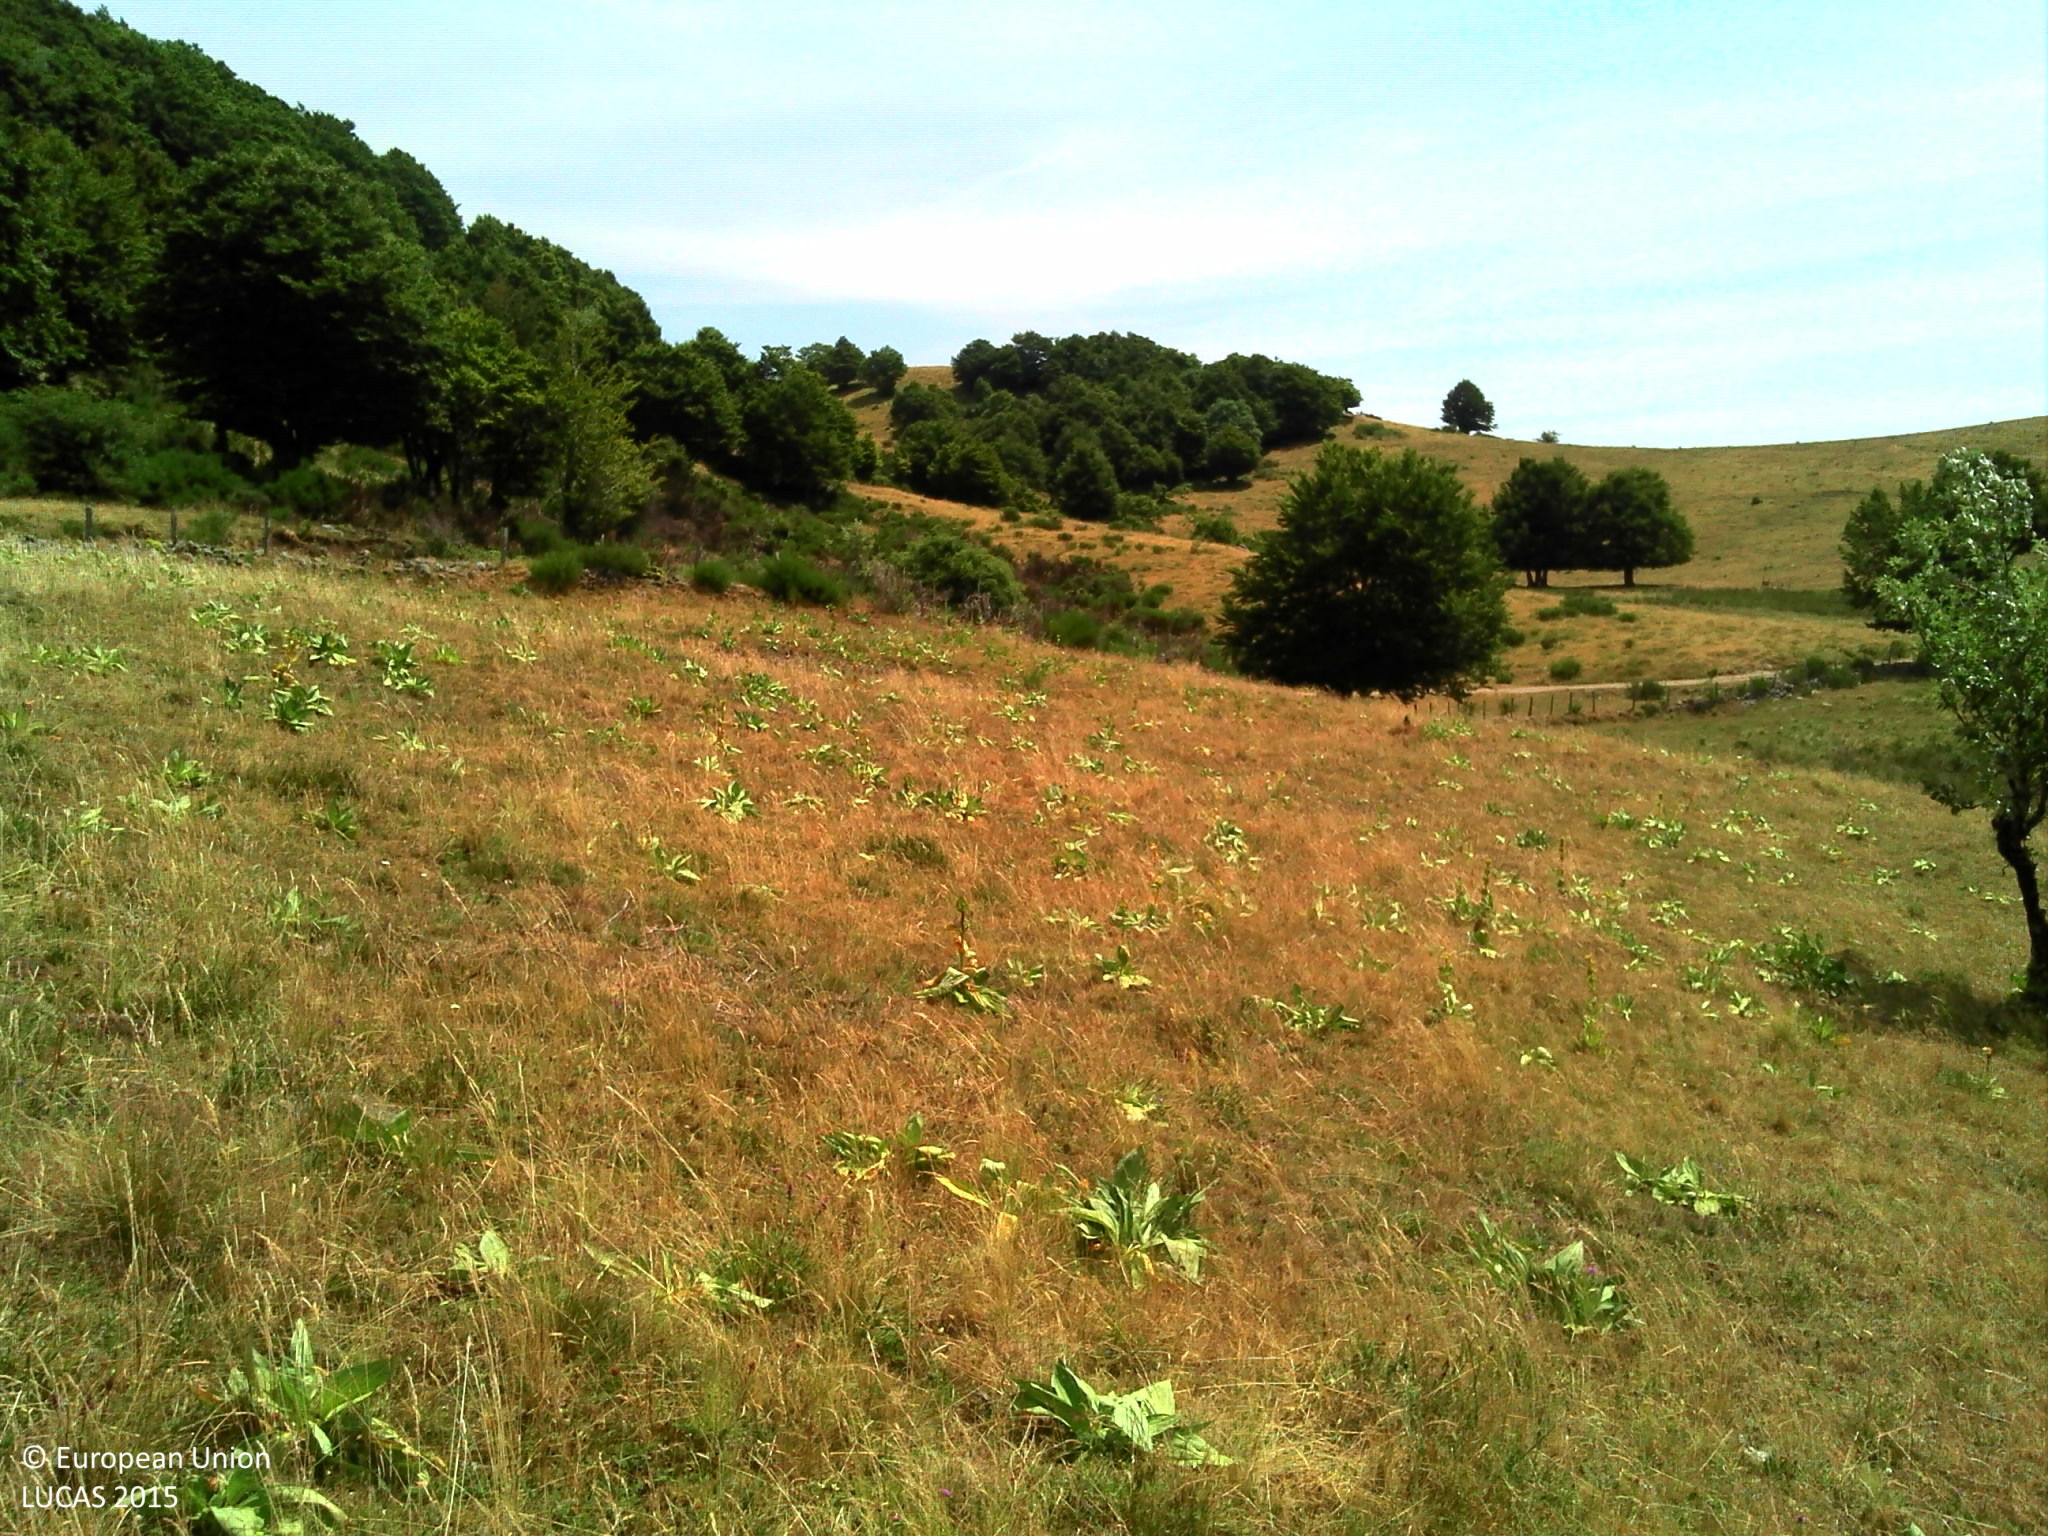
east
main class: Grassland
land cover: Grassland without tree/shrub cover
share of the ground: > 75 %
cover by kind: herbaceous plants 95 %, shrubs 5 %
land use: Agriculture (excluding fallow land and kitchen gardens)
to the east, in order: Grassland without tree/shrub cover; Dry stone walls; Fences; Tracks; Shrubland without tree cover
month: July
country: FR
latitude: 44.5692
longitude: 3.0406
